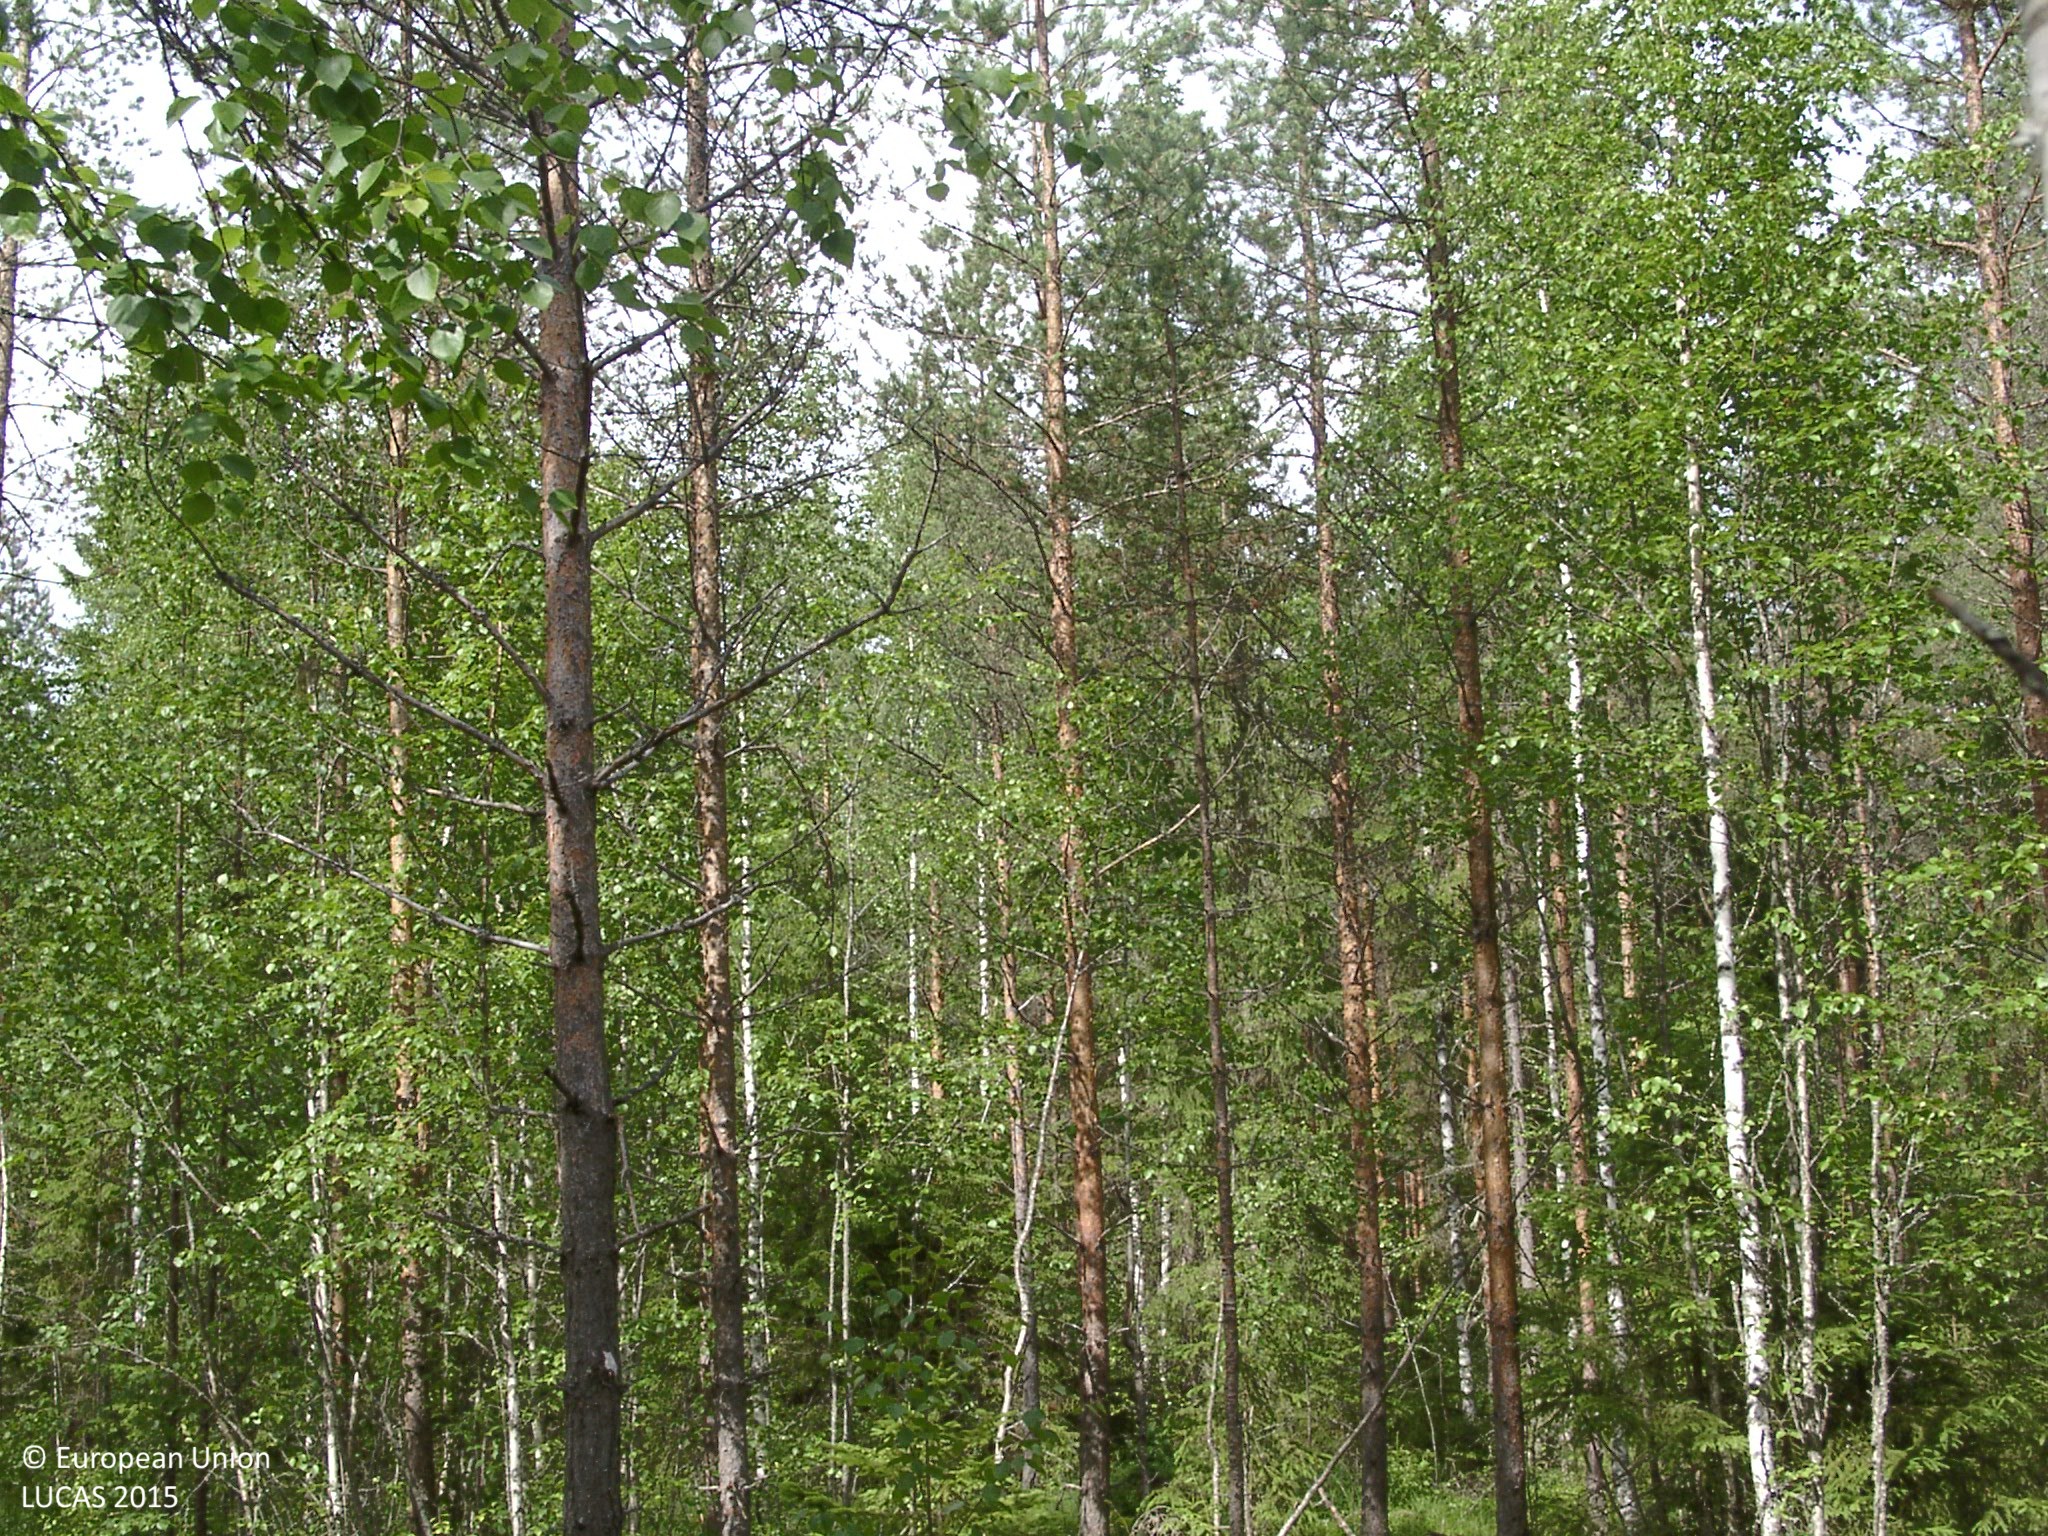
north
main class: Woodland
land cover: Pine dominated mixed woodland
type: boreal forest
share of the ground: 50 - 75 %
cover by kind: coniferous forest trees 45 %, broadleaved forest trees 15 %, shrubs 15 %, herbaceous plants 10 %, lichens and mosses 10 %
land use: Forestry
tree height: > 5 m
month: July
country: FI
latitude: 62.1678
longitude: 25.1790
